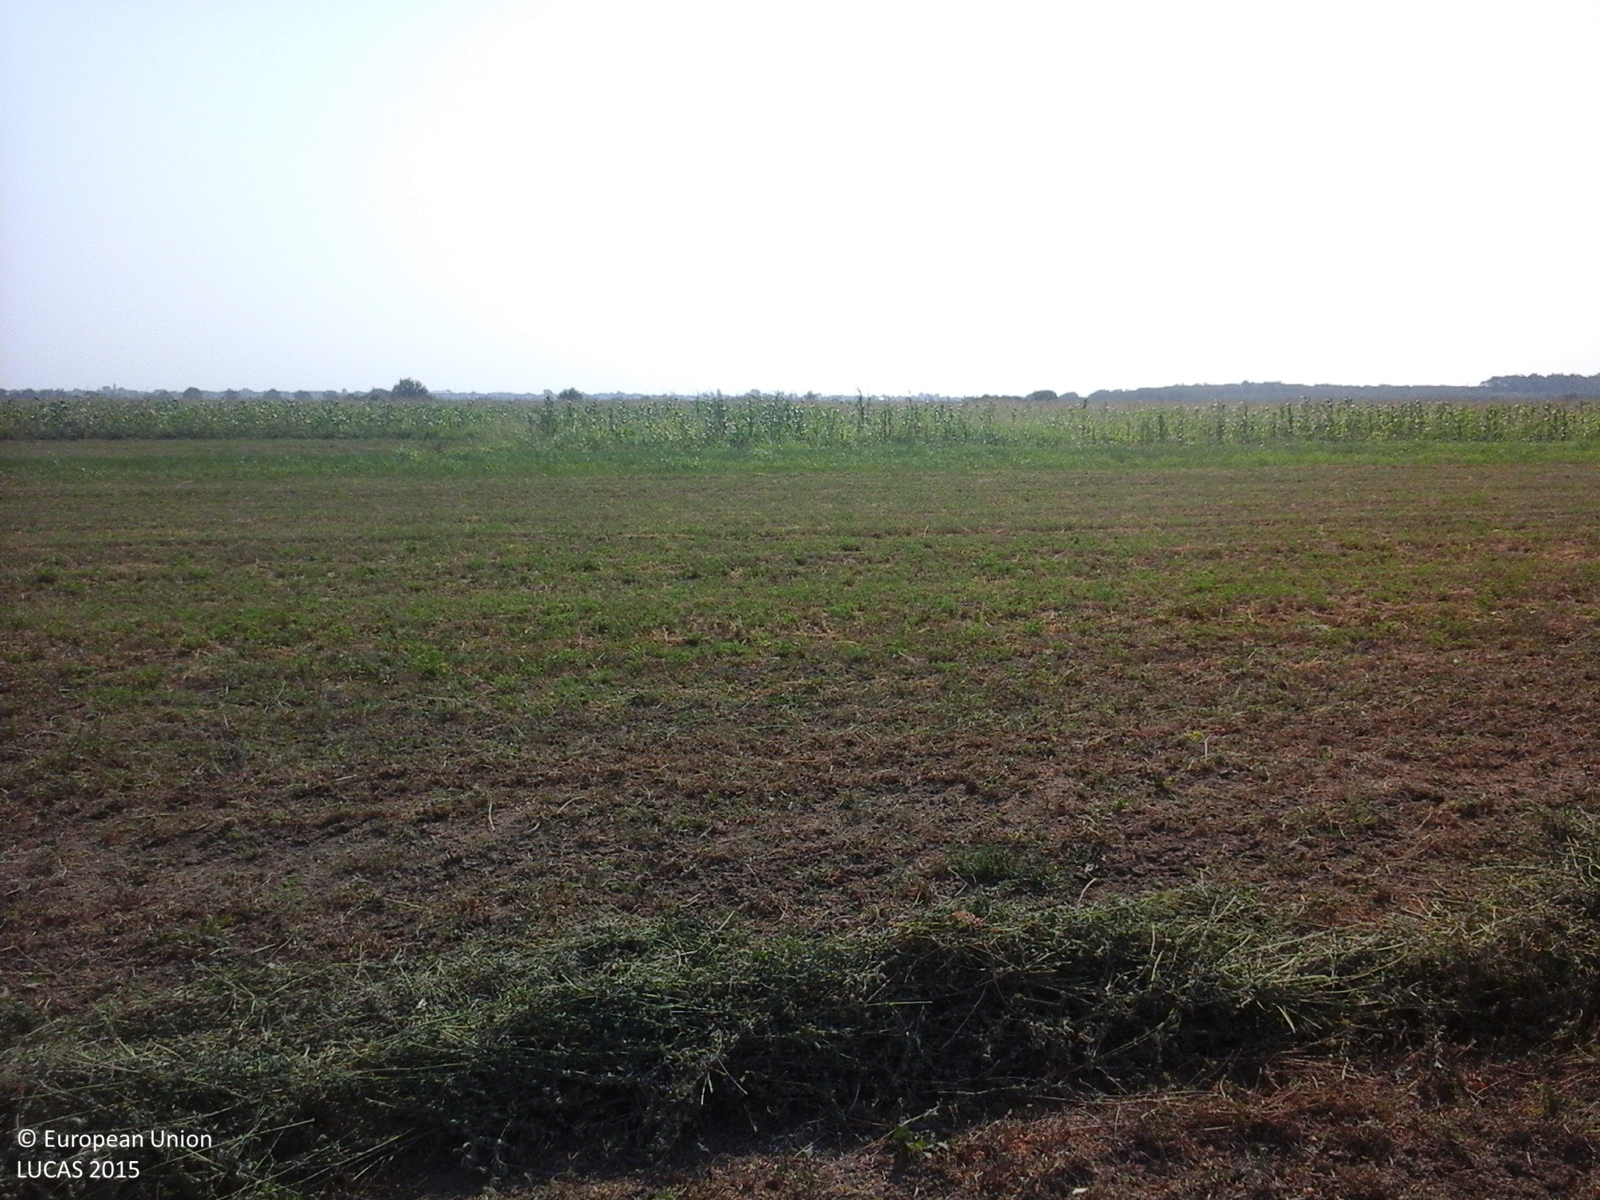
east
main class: Cropland
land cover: Lucerne
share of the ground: 10 - 25 %
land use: Agriculture (excluding fallow land and kitchen gardens)
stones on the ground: < 10 %
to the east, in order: Lucerne; Maize; Sunflower; Maize
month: July
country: RO
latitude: 45.6505
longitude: 27.4906
